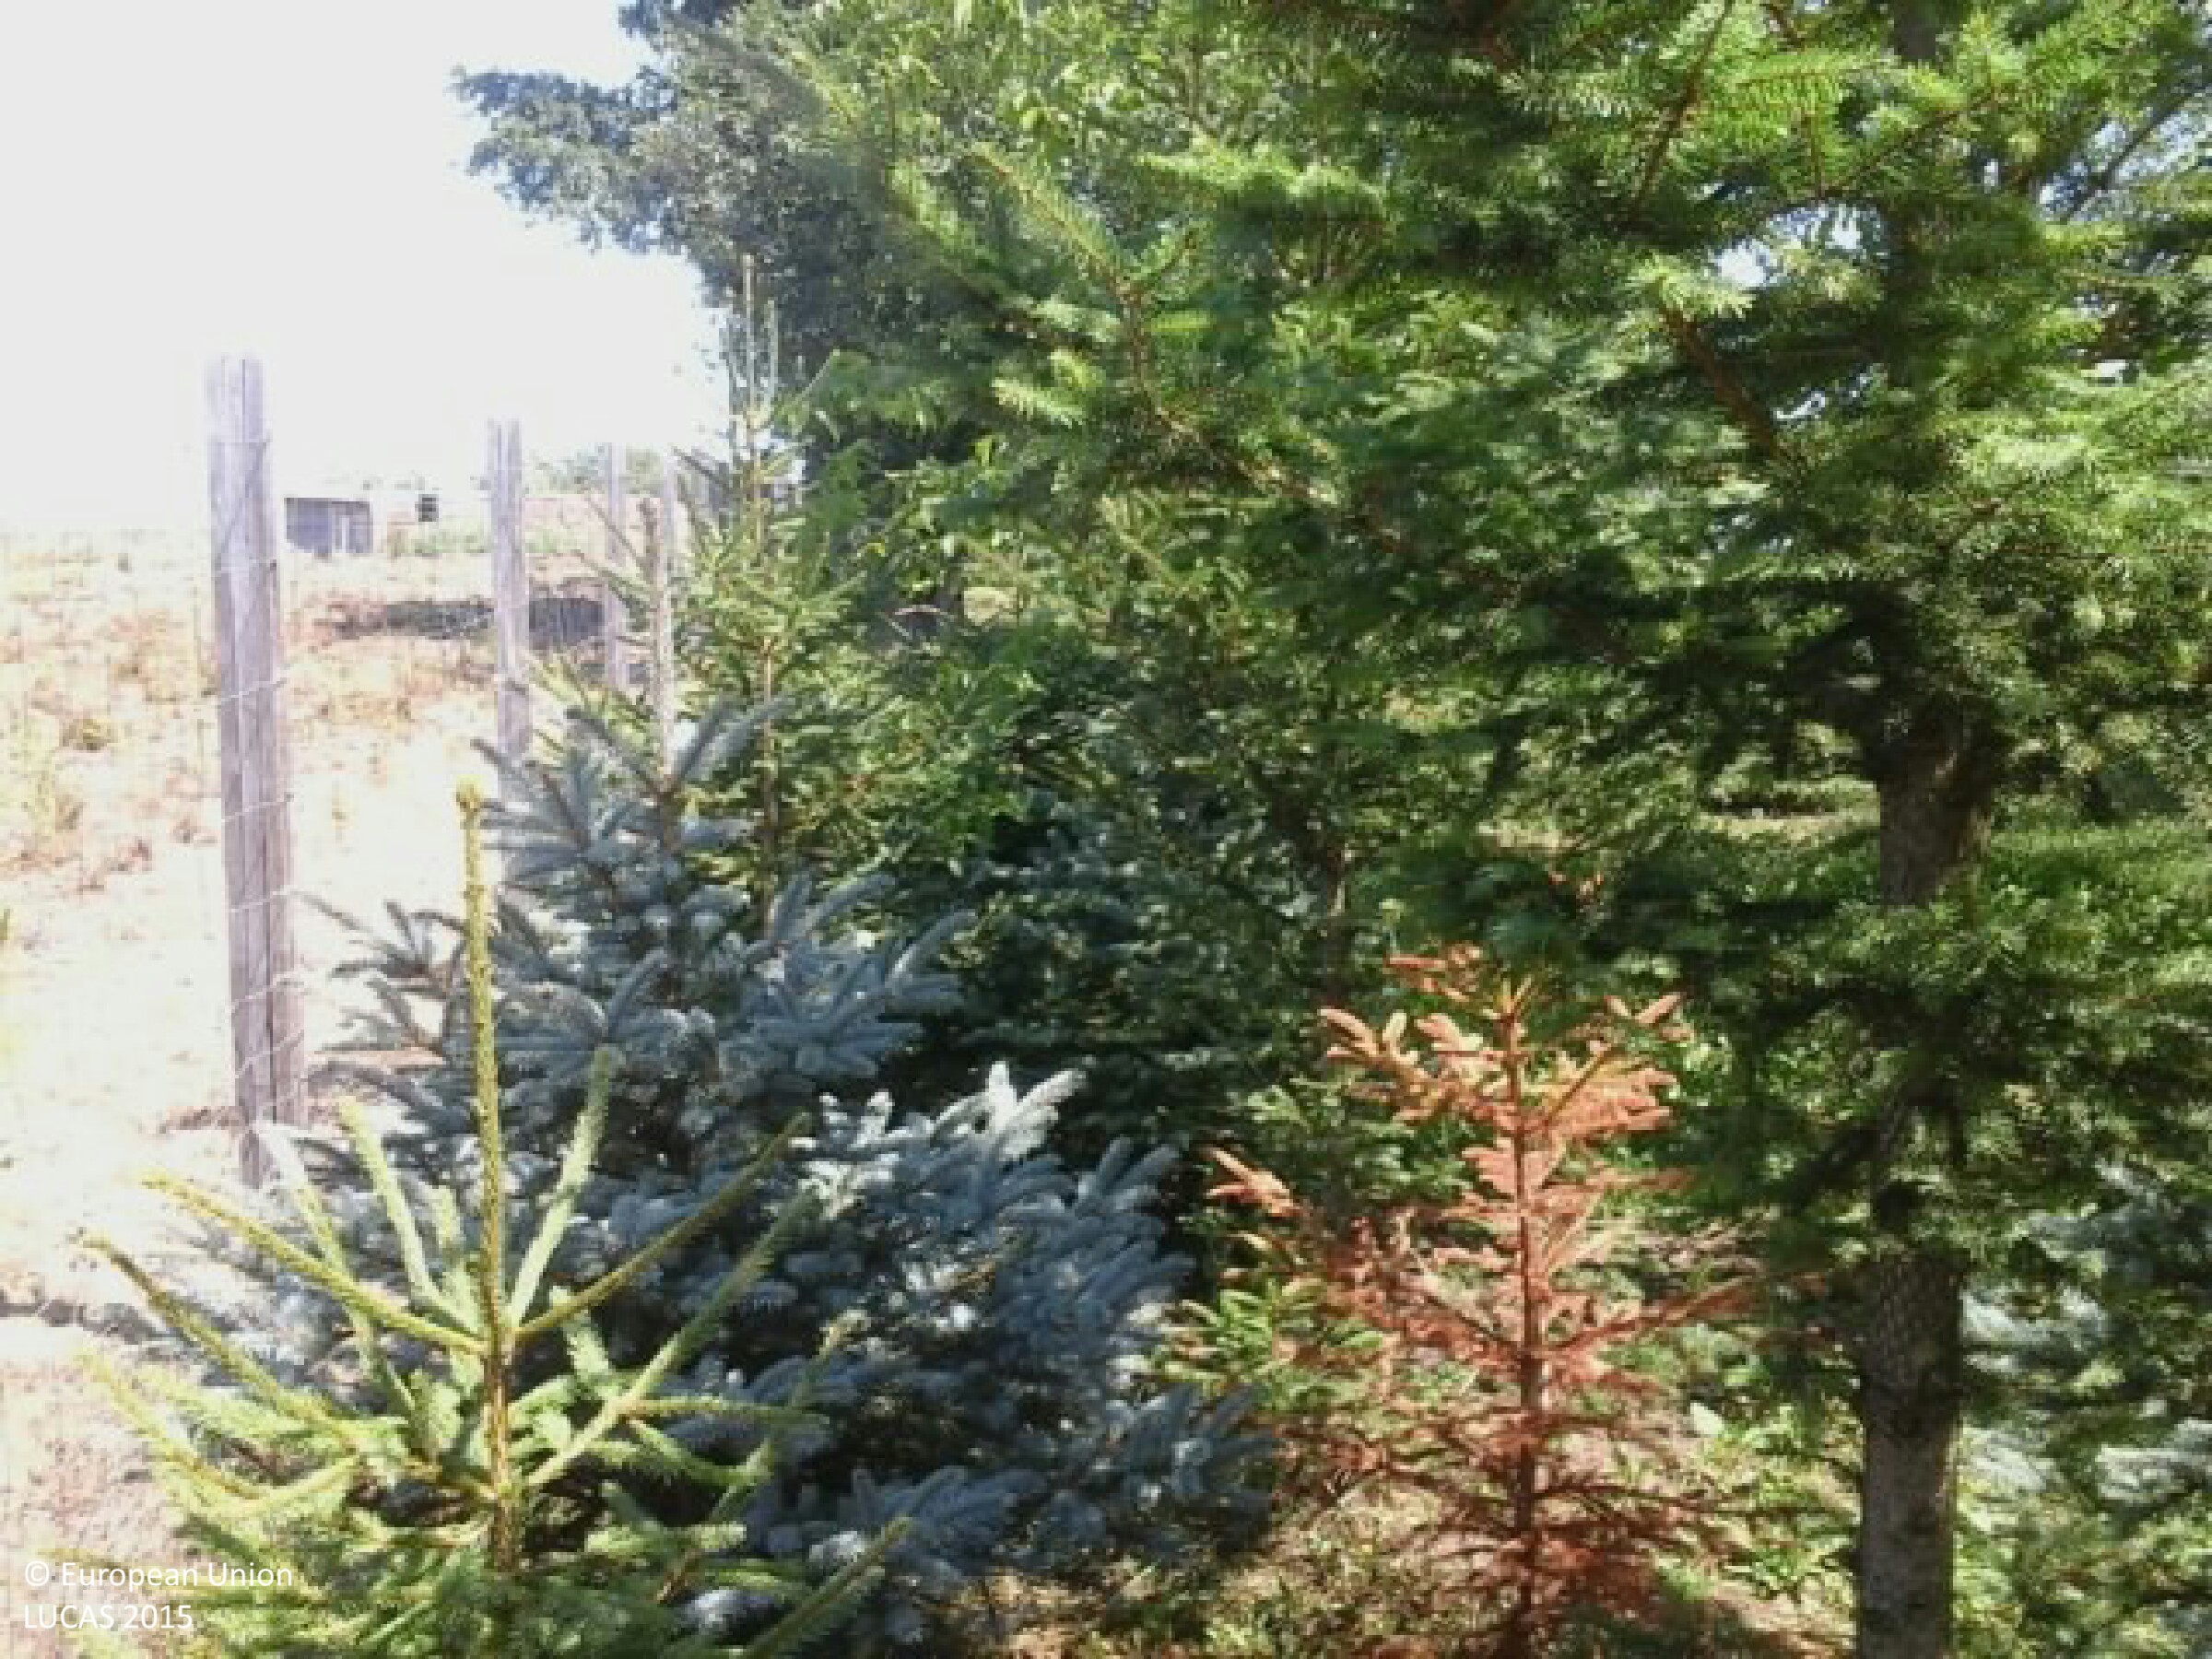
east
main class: Cropland
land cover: Nurseries
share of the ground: 25 - 50 %
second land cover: Spontaneously vegetated surfaces
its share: 50 - 75 %
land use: Forestry
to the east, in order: Nurseries; Spontaneously vegetated surfaces; Nurseries; Fences; Grass margins; Broadleaved woodland
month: July
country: HU
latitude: 46.2795
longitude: 17.0754
